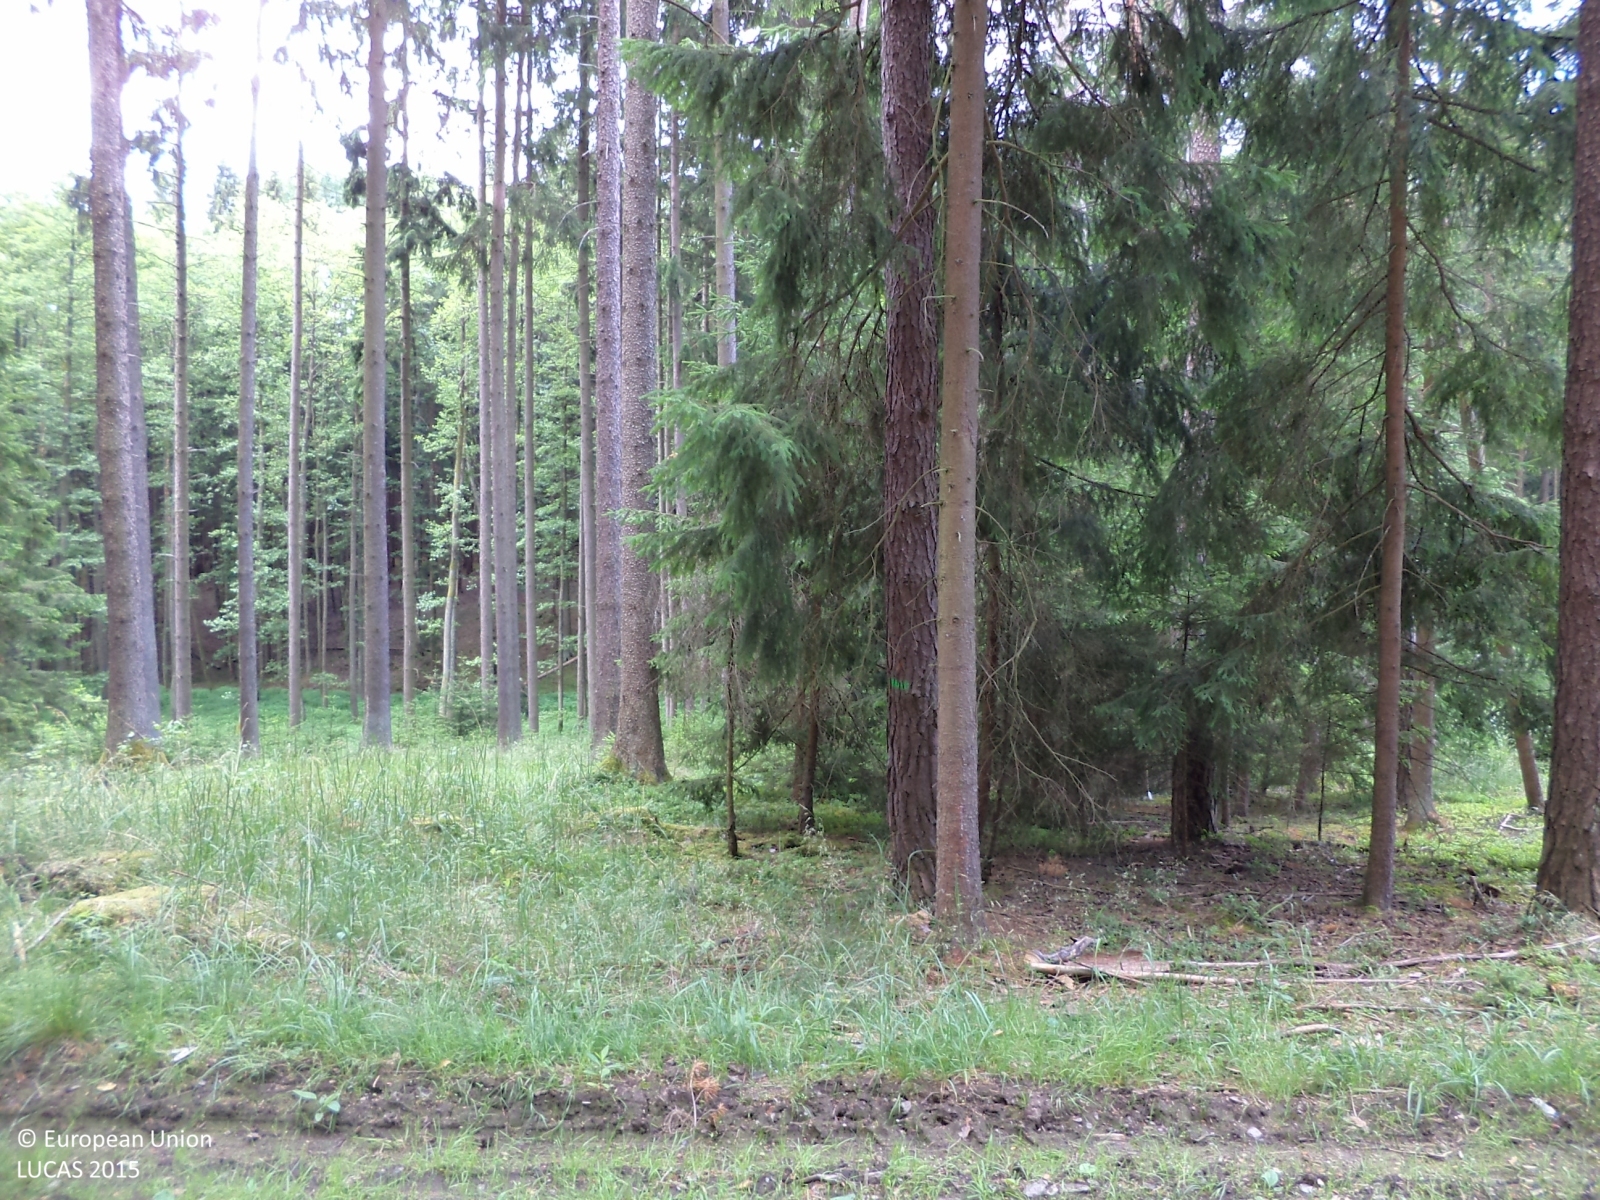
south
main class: Woodland
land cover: Pine dominated coniferous woodland
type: hemiboreal forest and nemoral coniferous forest and mixed broadleaved-coniferous forest
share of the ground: > 75 %
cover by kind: coniferous forest trees 80 %, herbaceous plants 10 %, lichens and mosses 10 %
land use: Forestry
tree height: > 5 m
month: June
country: CZ
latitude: 49.3524
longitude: 14.6134
